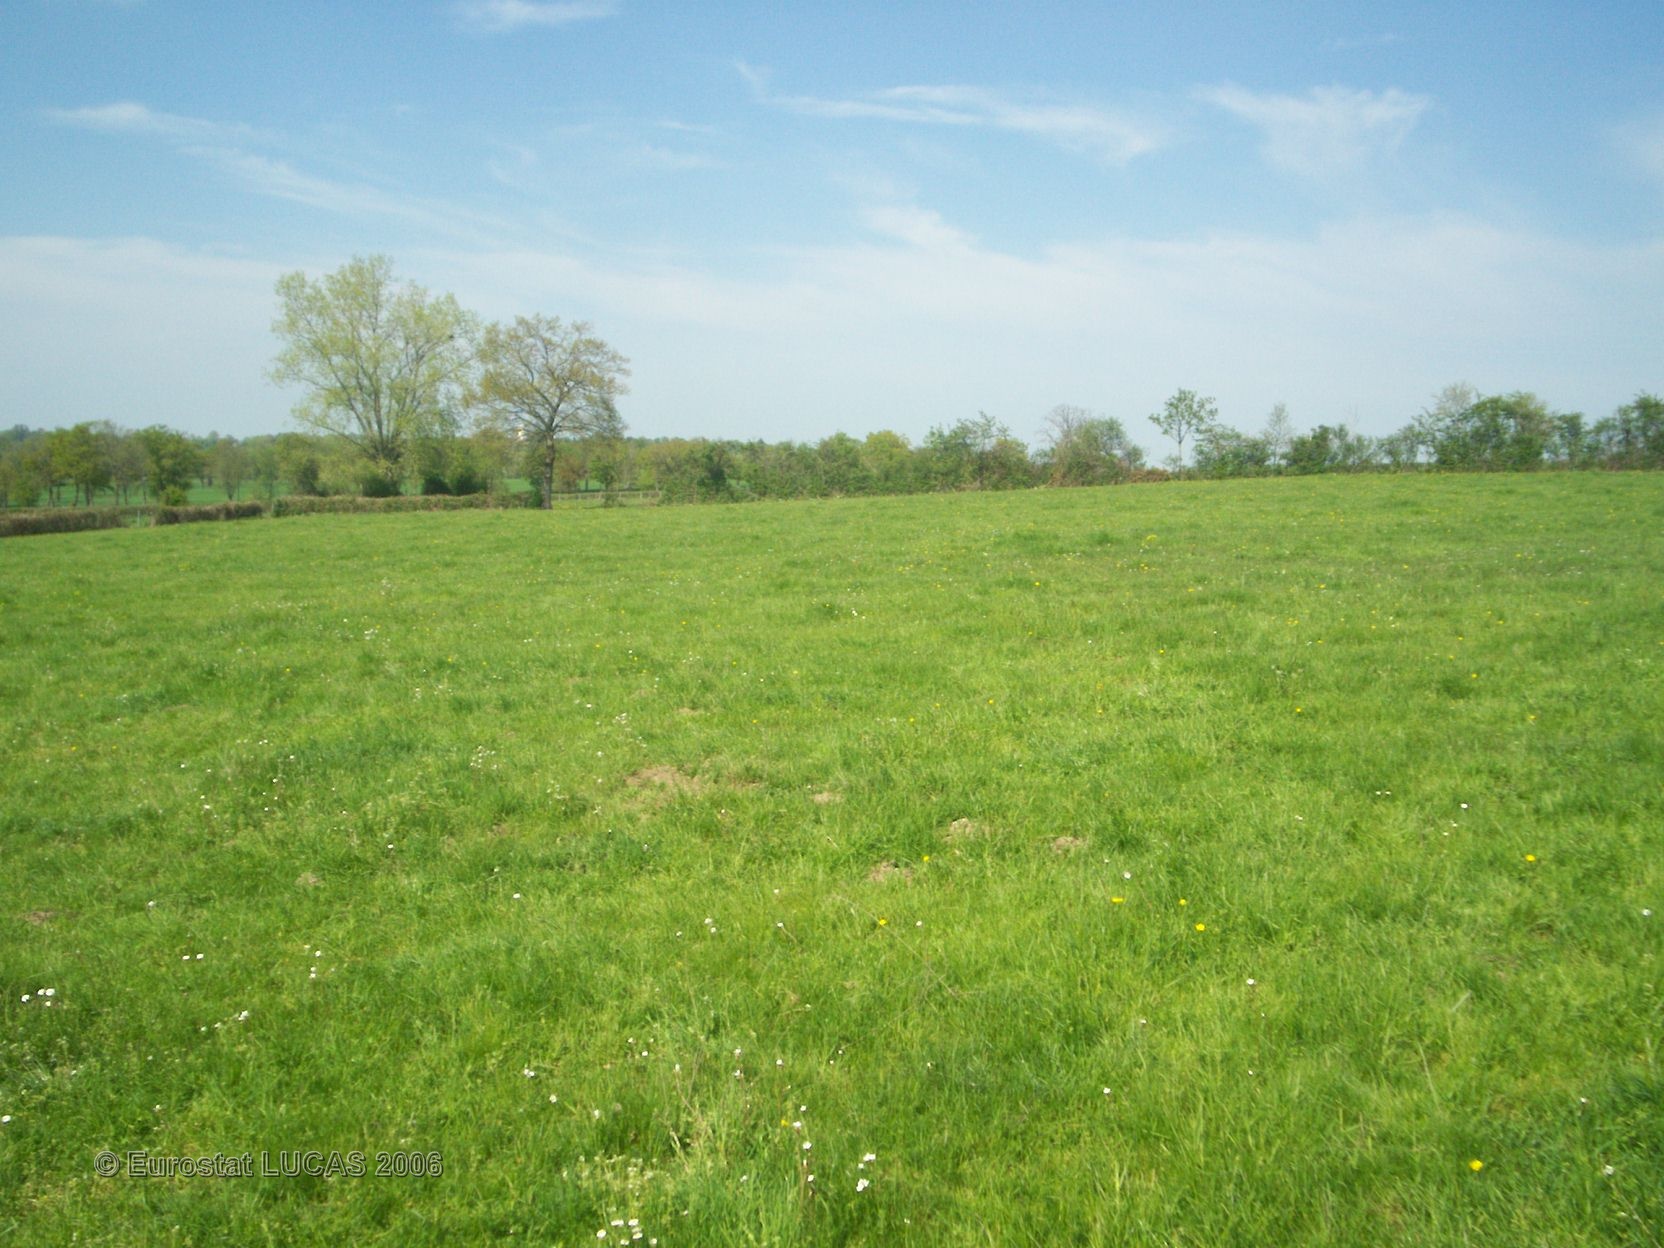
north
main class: Grassland
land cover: Grassland without tree/shrub cover
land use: Agriculture (excluding fallow land and kitchen gardens)
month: May
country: FR
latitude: 46.3288
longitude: 3.1266
